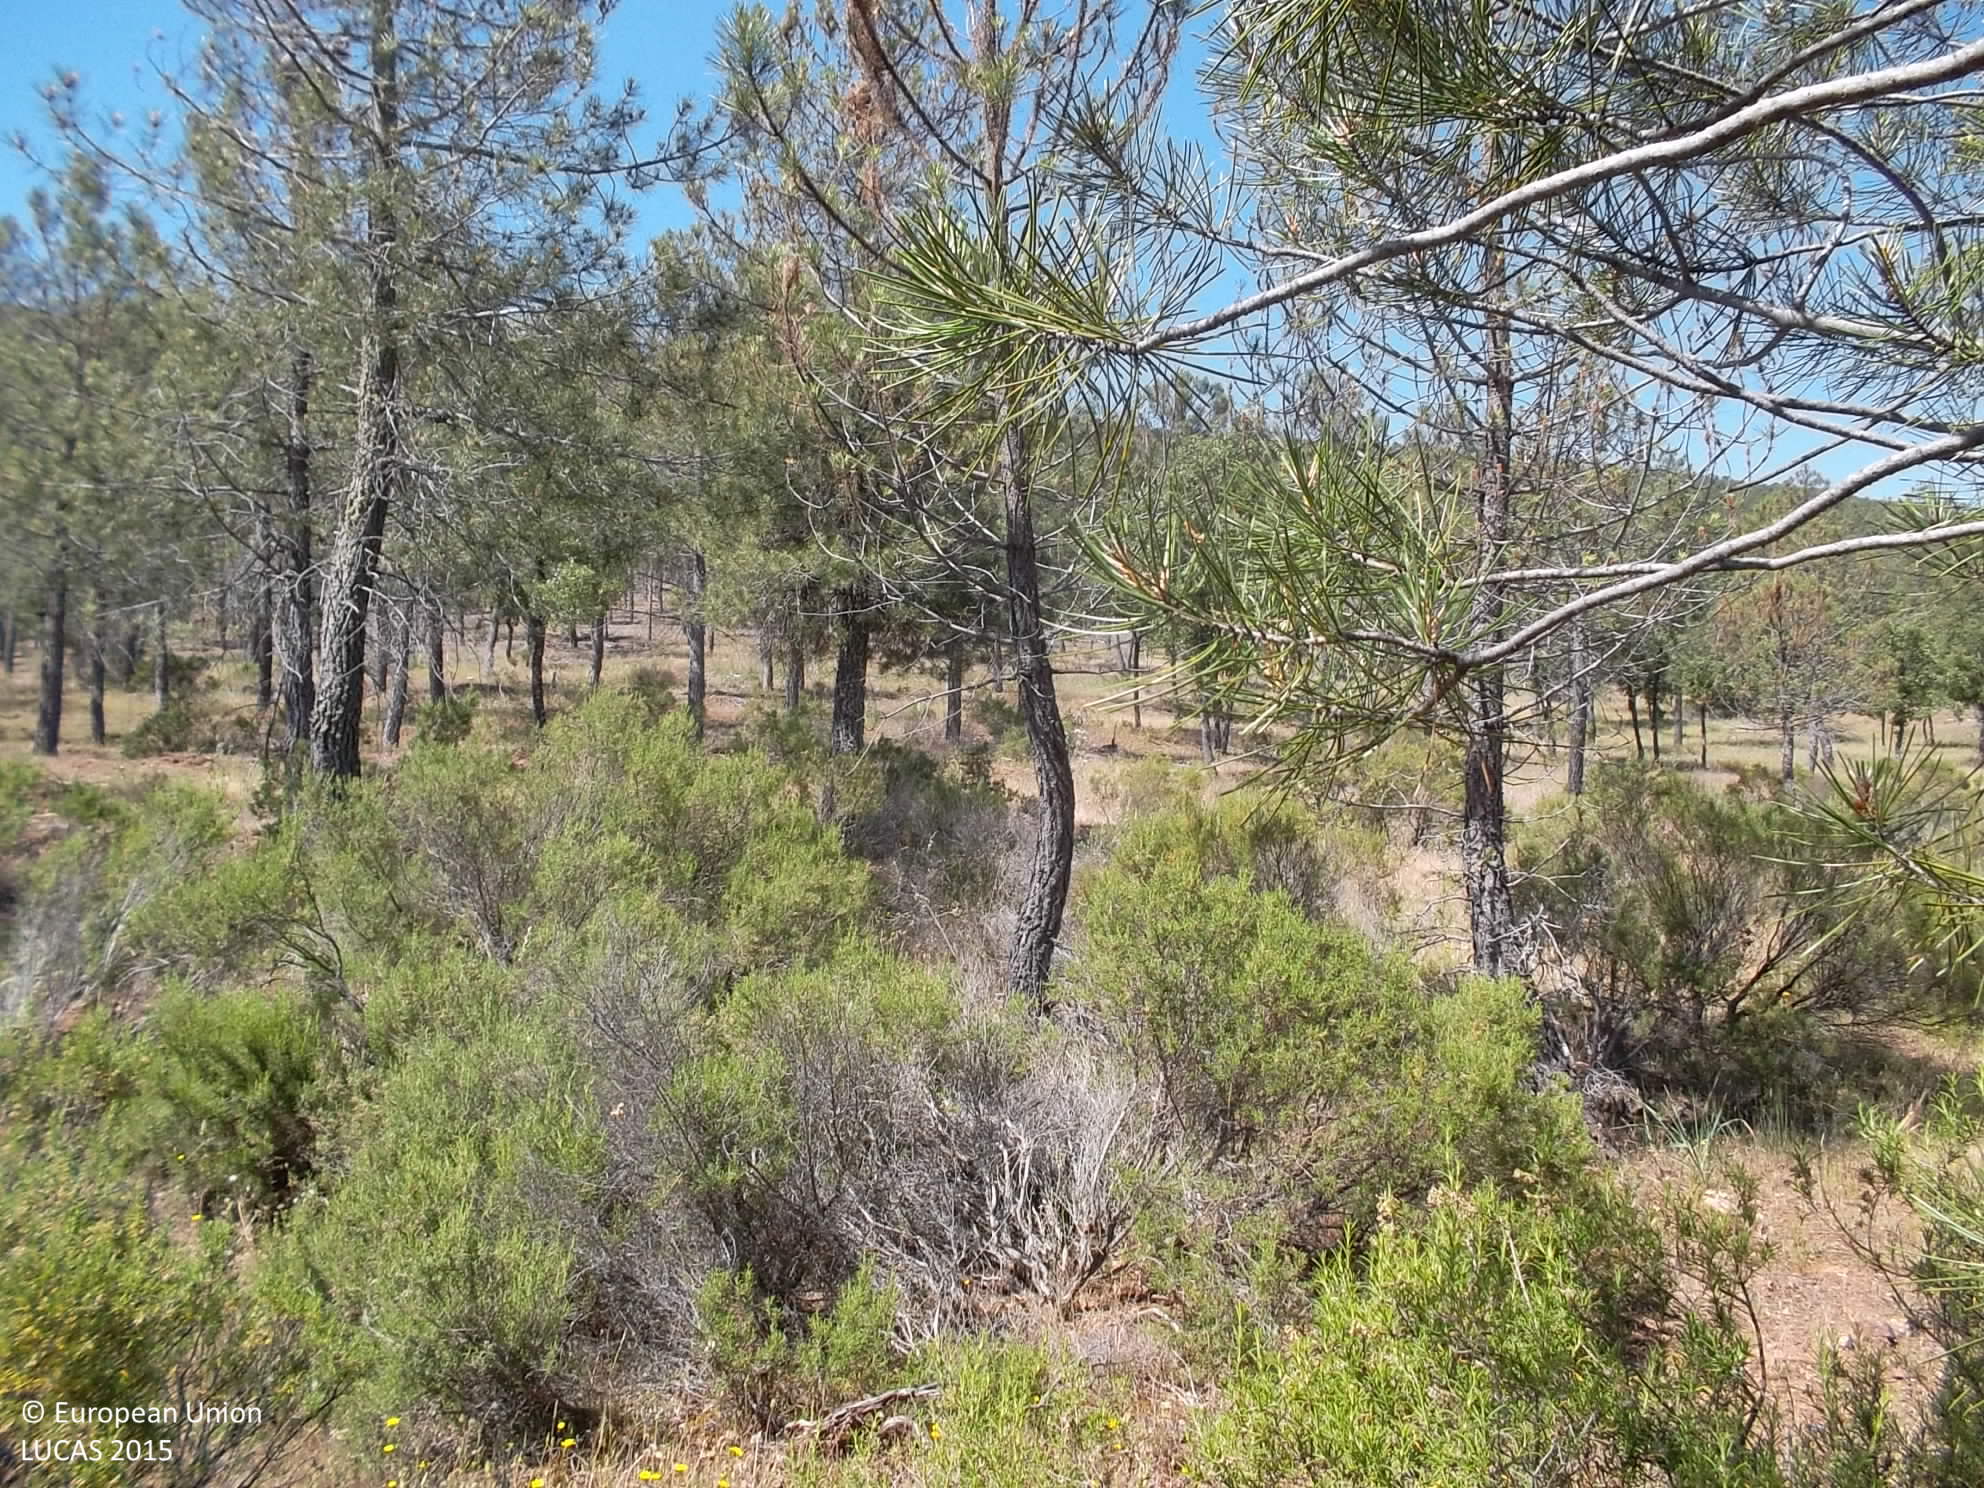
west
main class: Woodland
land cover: Pine dominated coniferous woodland
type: alpine coniferous forest
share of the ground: > 75 %
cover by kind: coniferous forest trees 40 %, herbaceous plants 40 %, shrubs 20 %
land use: Forestry
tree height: > 5 m
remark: Clear cut
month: May
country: ES
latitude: 38.5320
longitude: -4.4399
